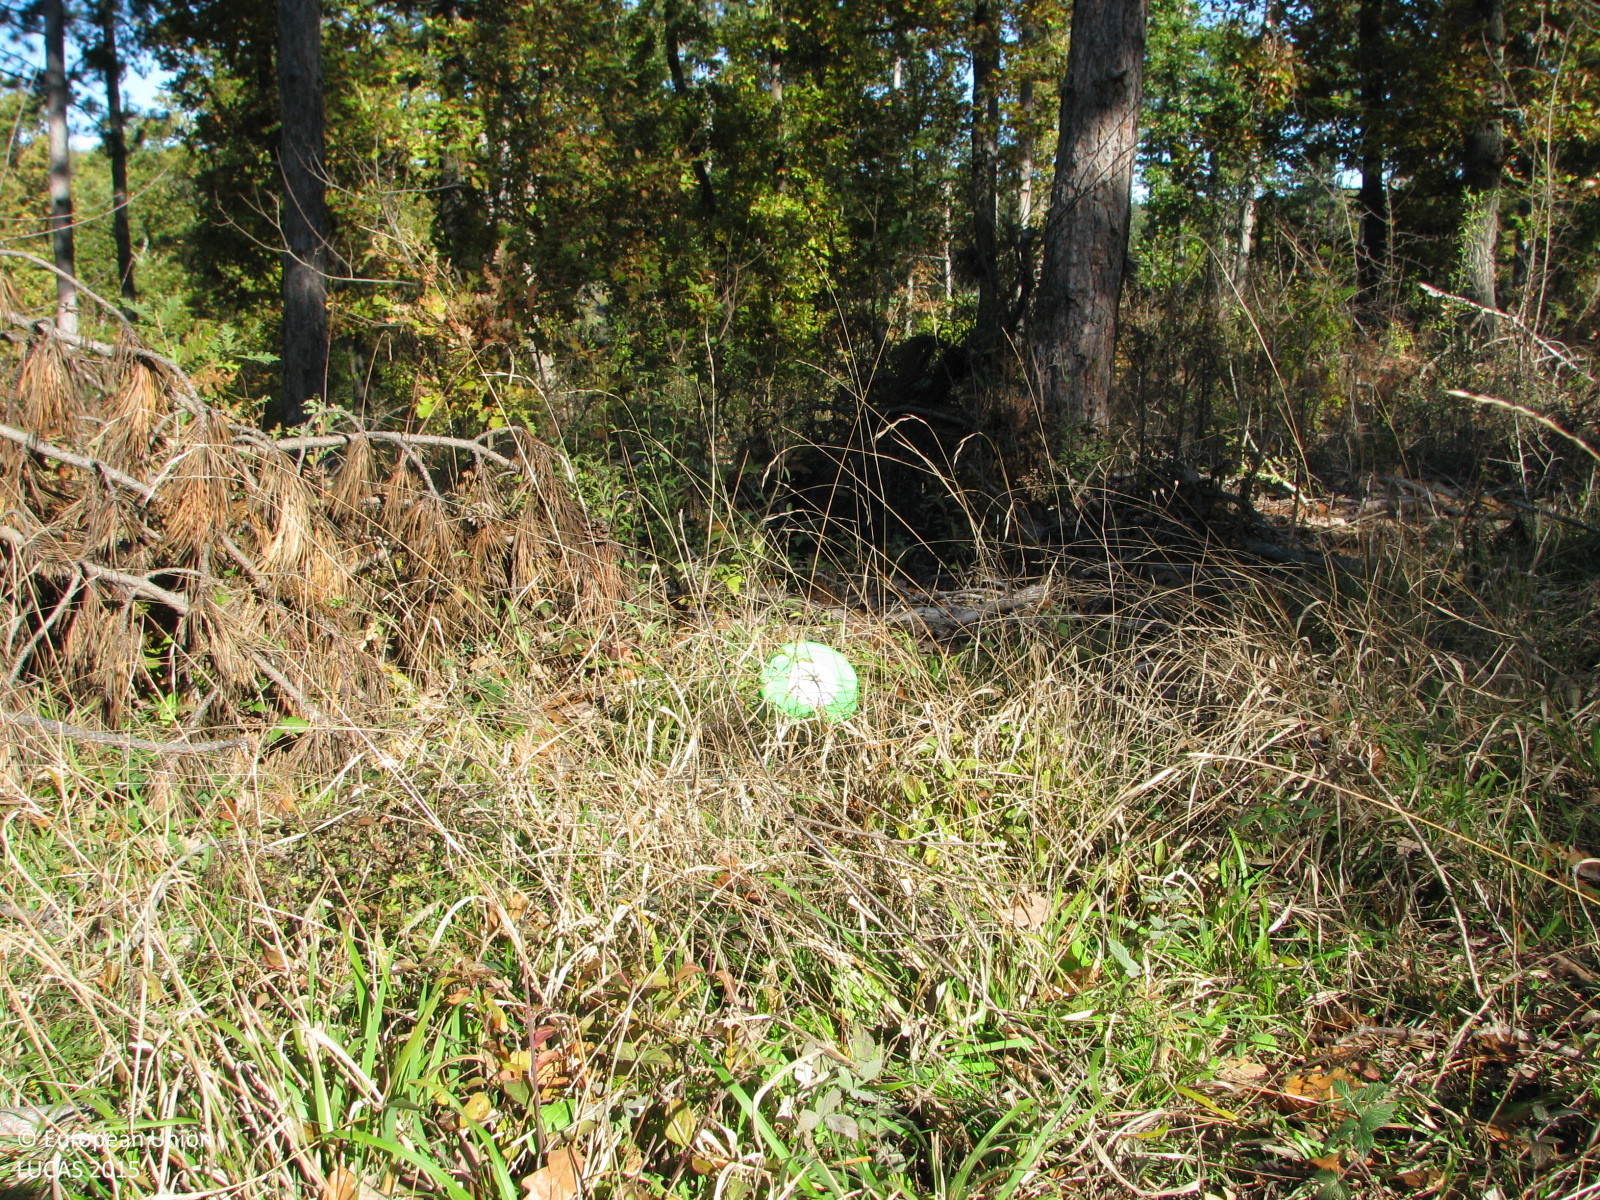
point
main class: Woodland
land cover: Pine dominated mixed woodland
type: hemiboreal forest and nemoral coniferous forest and mixed broadleaved-coniferous forest
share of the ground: 25 - 50 %
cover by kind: herbaceous plants 40 %, coniferous forest trees 30 %, broadleaved forest trees 20 %, shrubs 10 %
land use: Forestry
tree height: > 5 m
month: November
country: BG
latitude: 41.9901
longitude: 26.7123
